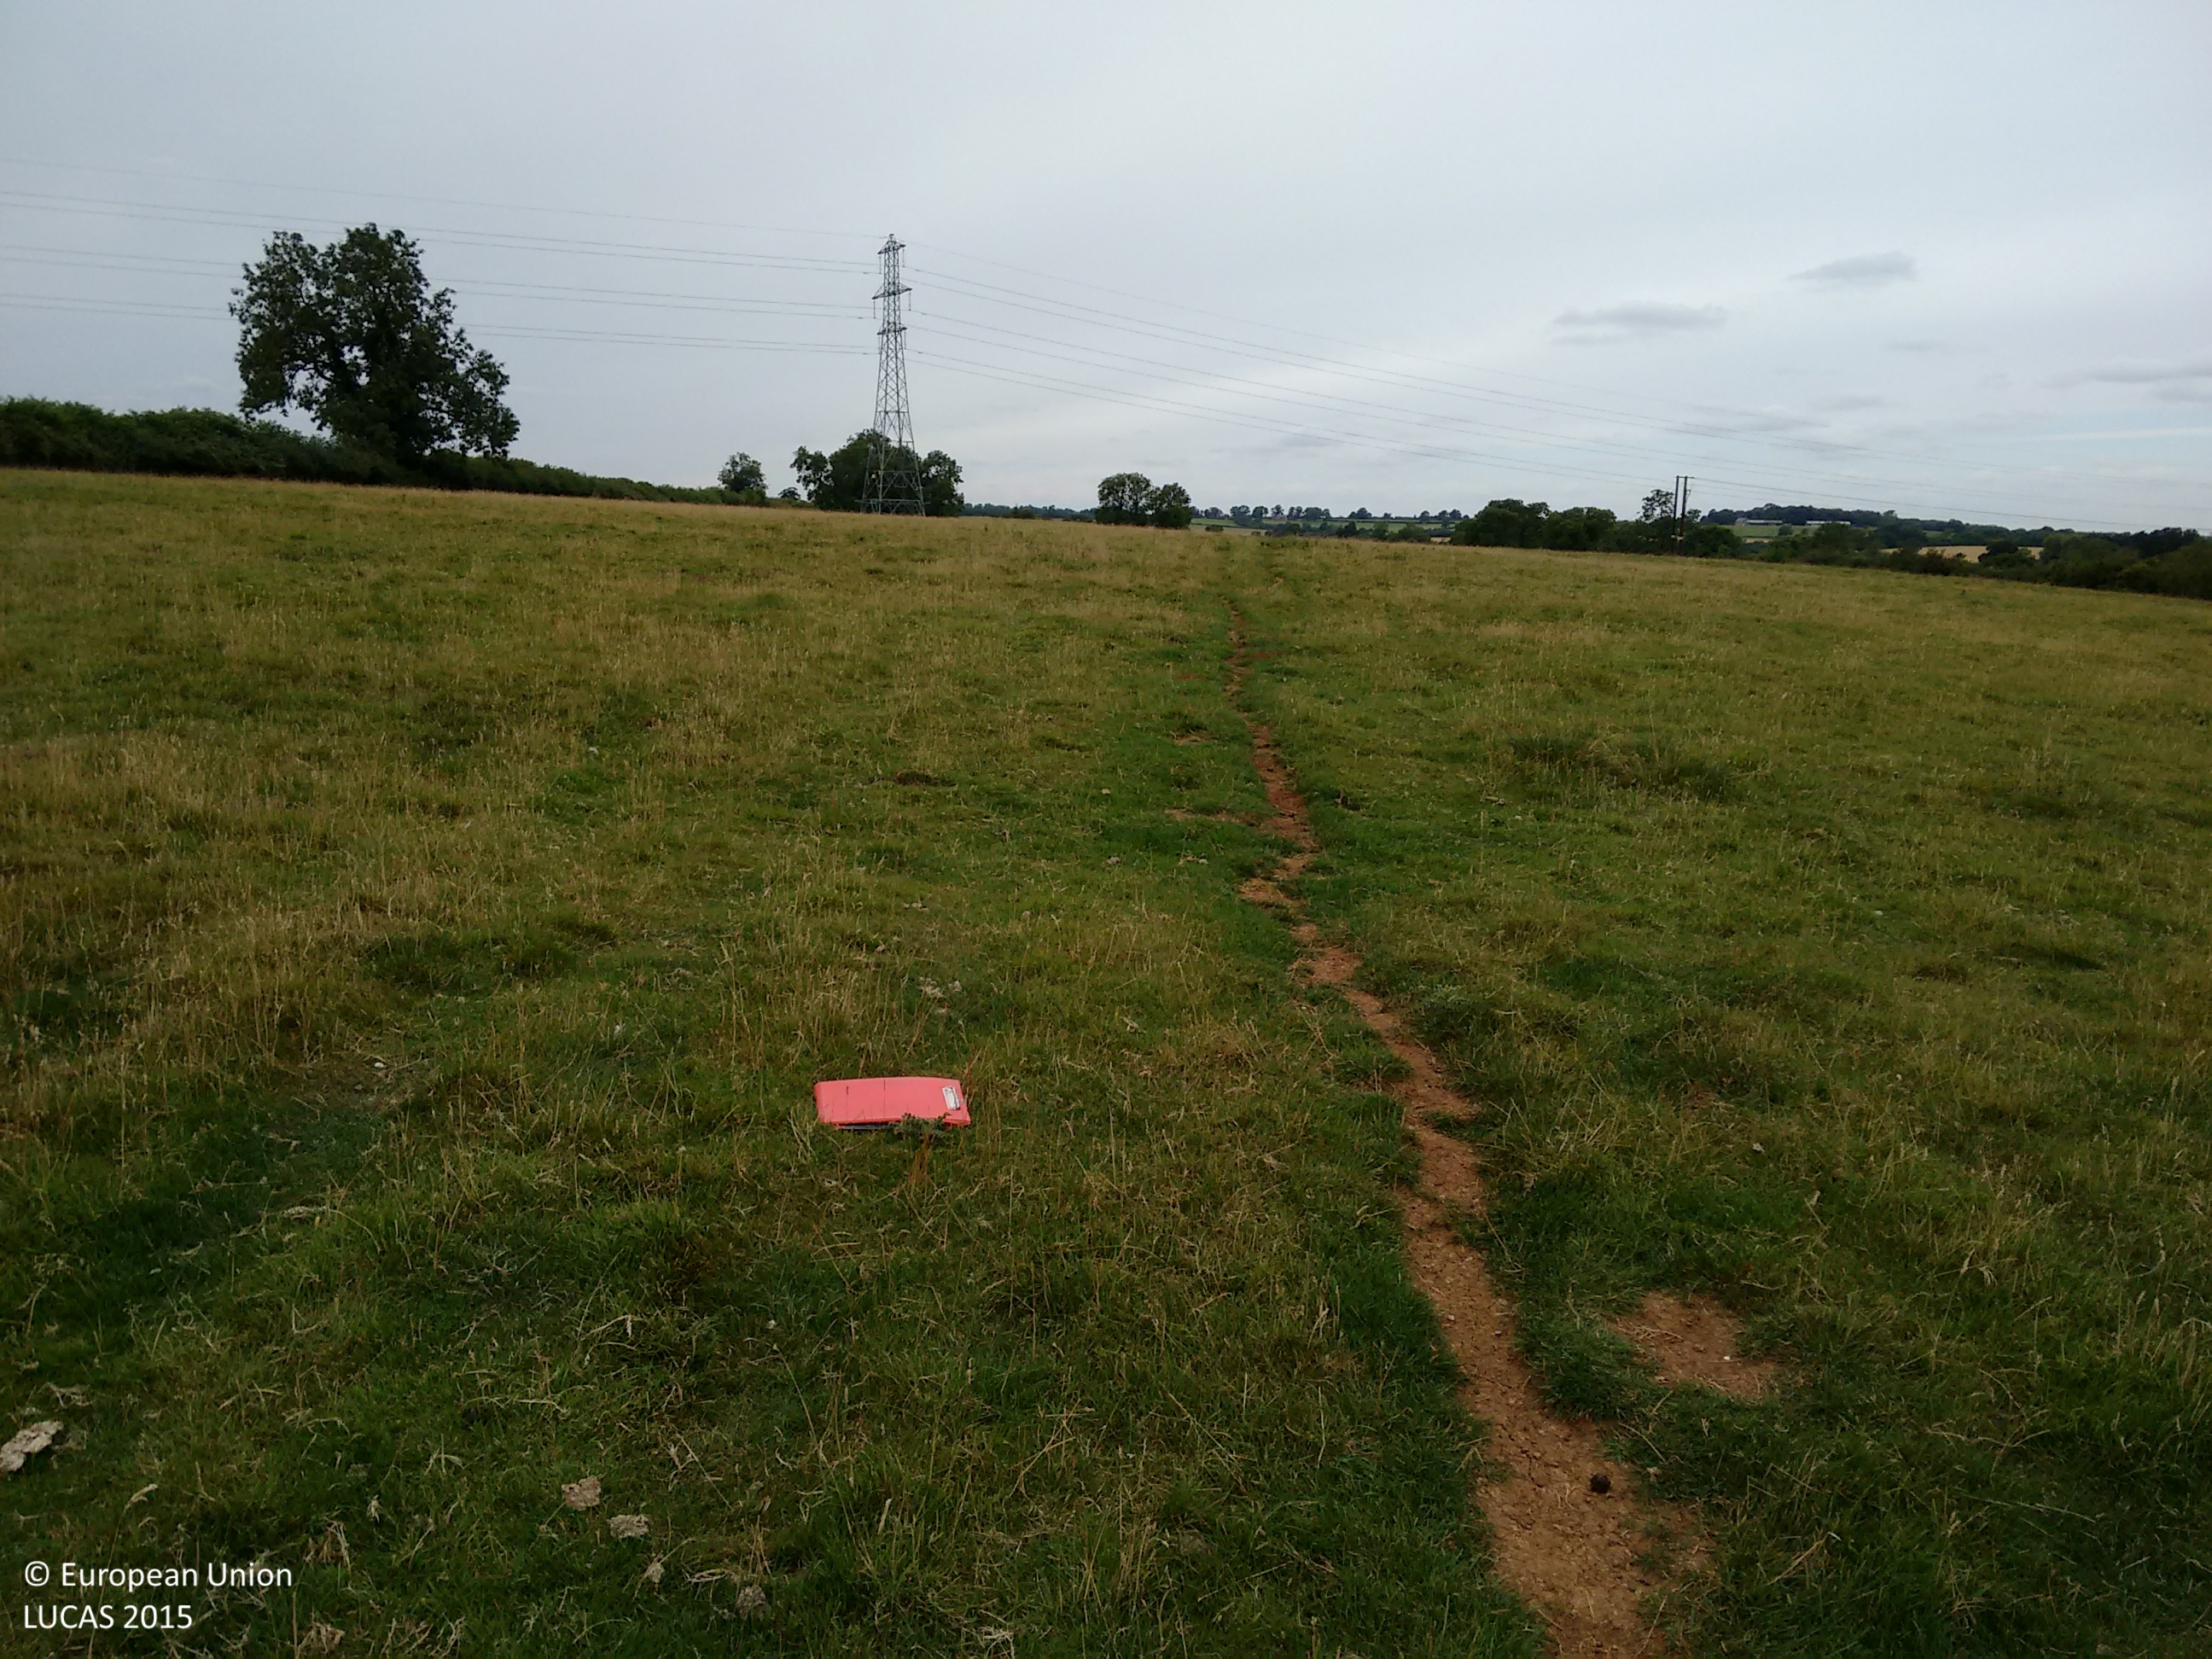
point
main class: Grassland
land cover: Grassland without tree/shrub cover
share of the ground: > 75 %
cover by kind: herbaceous plants 100 %
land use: Agriculture (excluding fallow land and kitchen gardens)
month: August
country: GB
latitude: 52.0657
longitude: -1.1767
